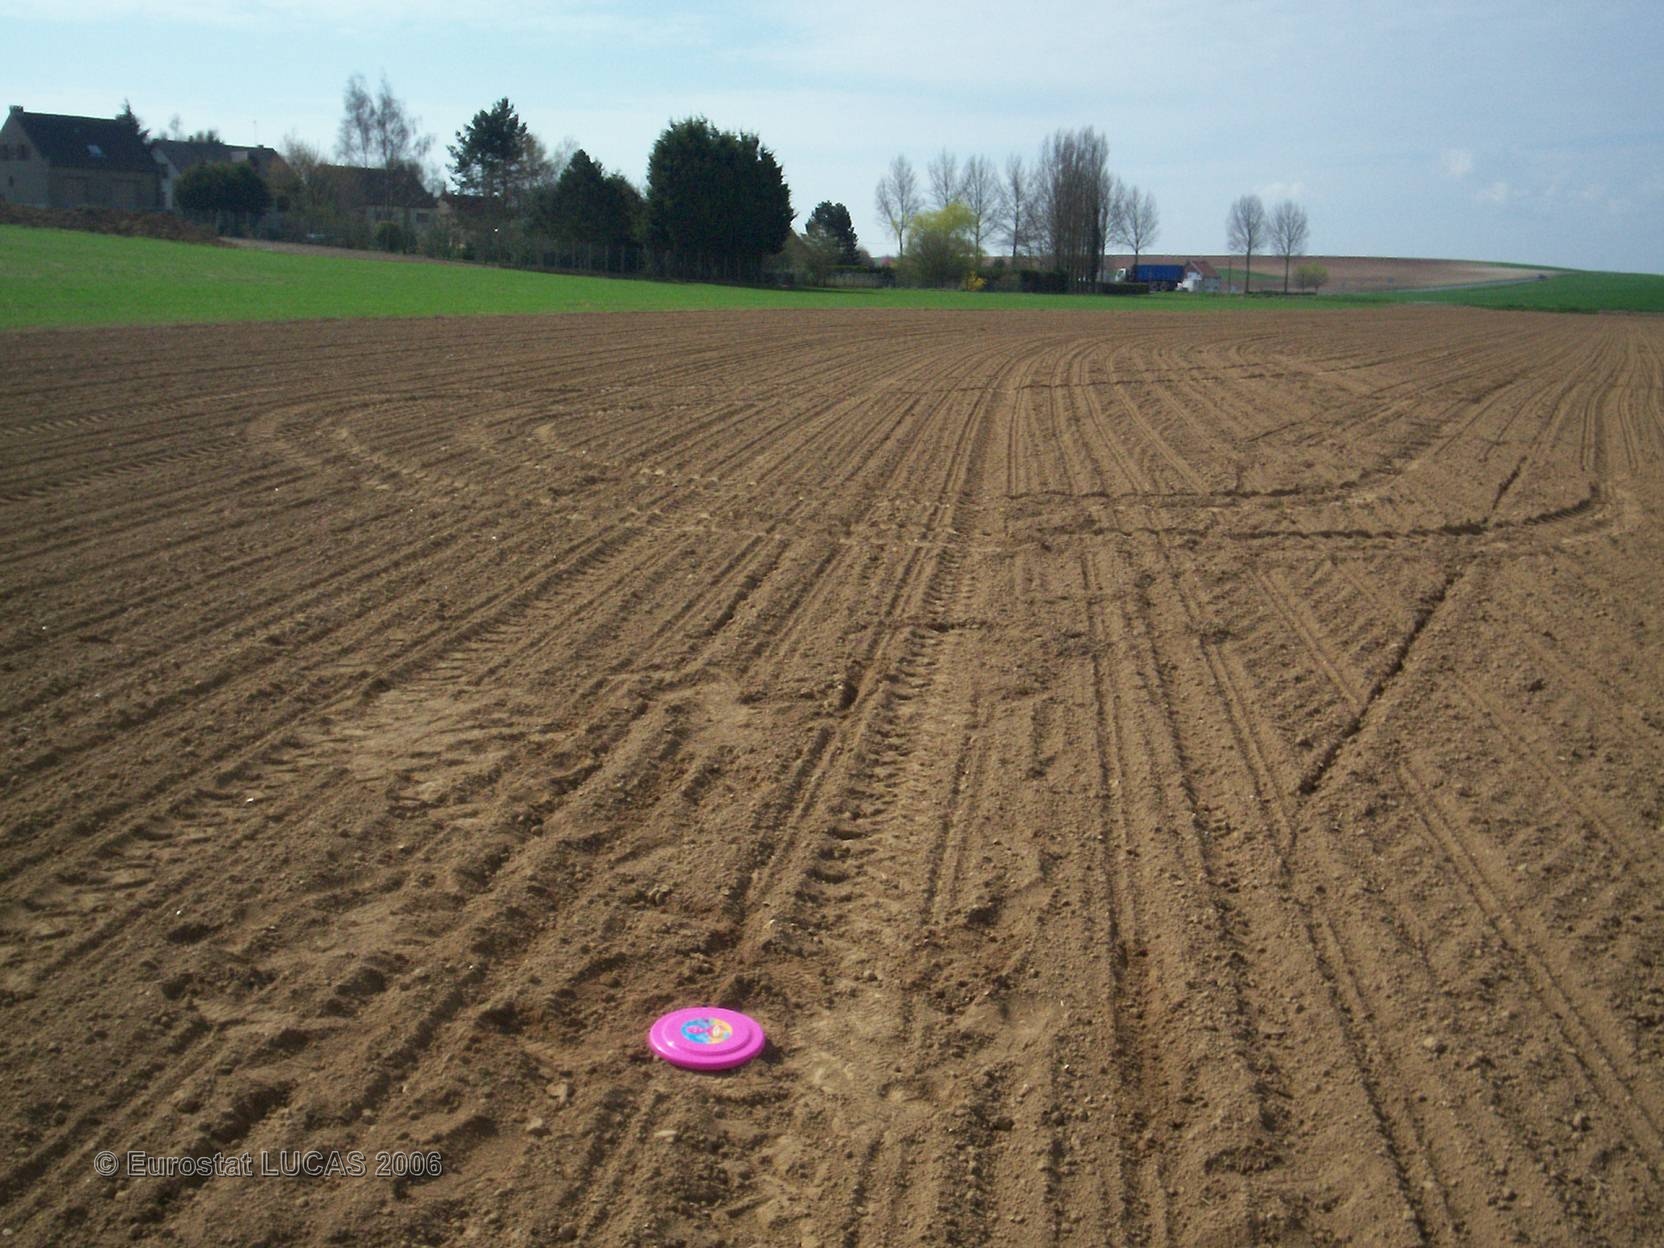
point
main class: Cropland
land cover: Sugar beet
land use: Agriculture (excluding fallow land and kitchen gardens)
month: April
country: FR
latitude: 50.0216
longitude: 2.6889
